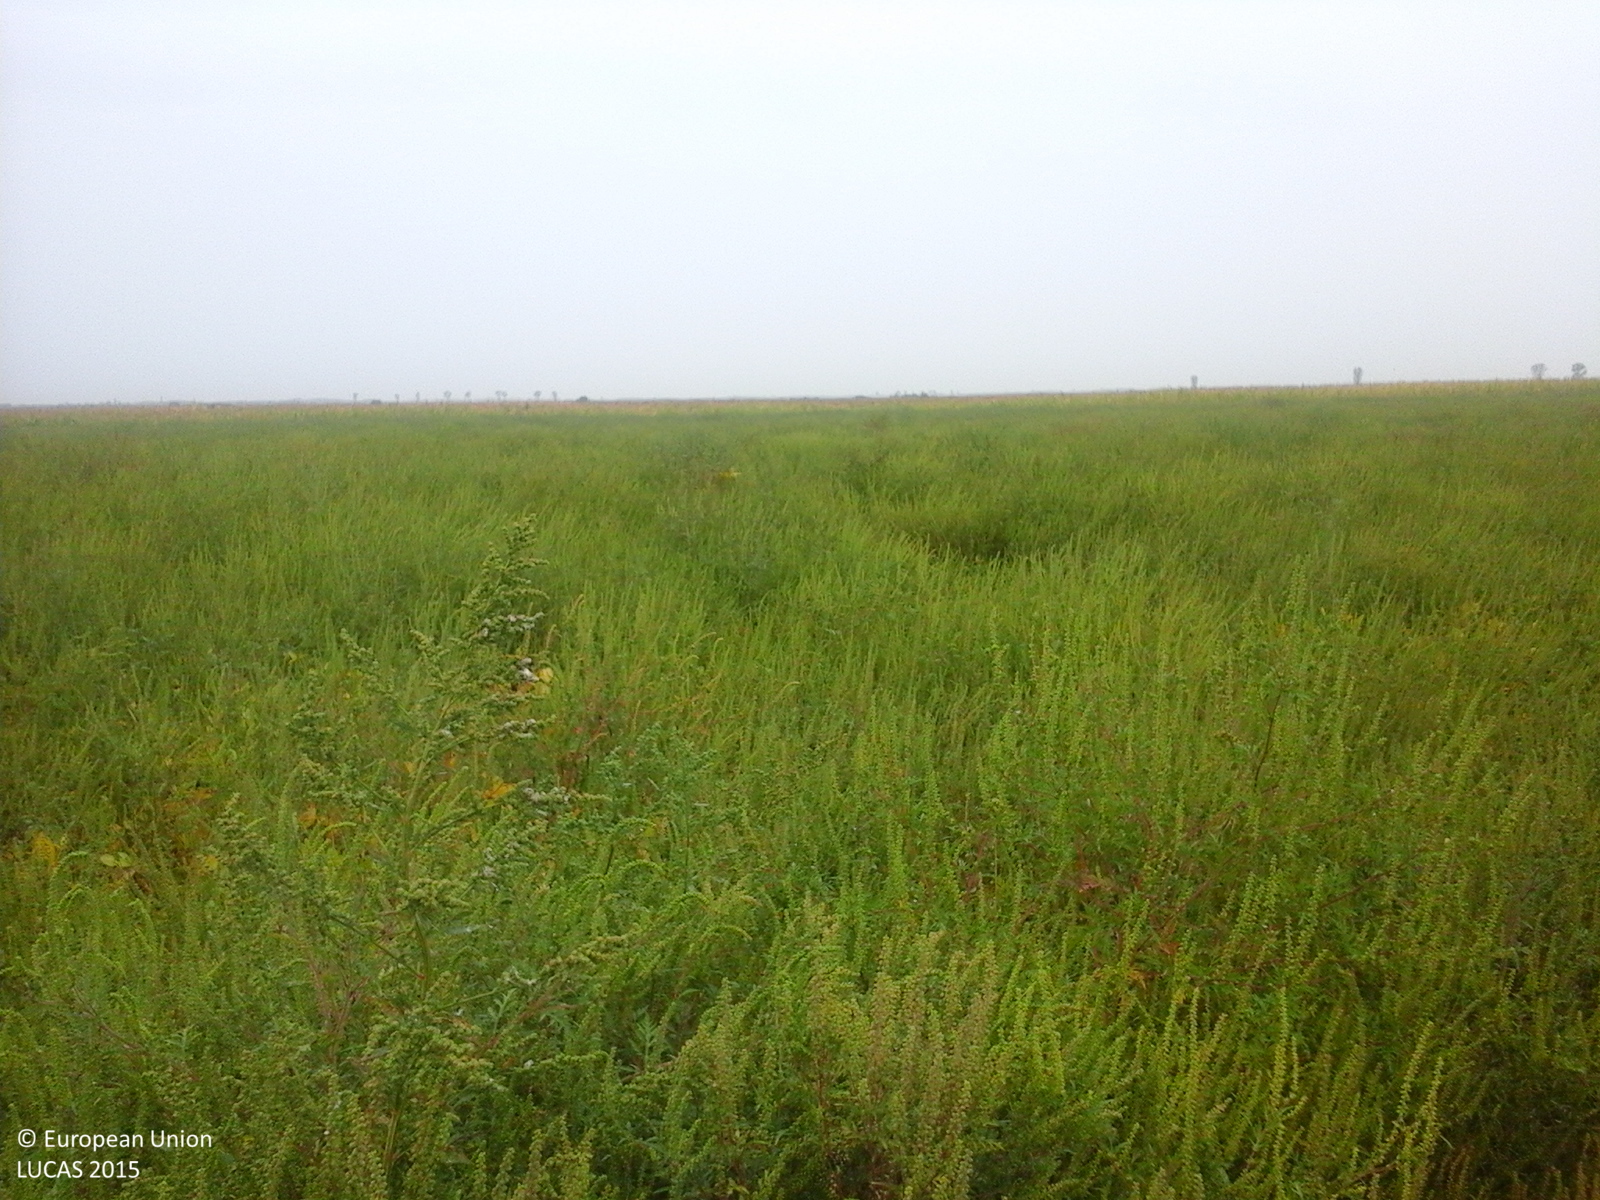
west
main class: Cropland
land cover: Soya
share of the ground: > 75 %
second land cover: Spontaneously vegetated surfaces
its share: > 75 %
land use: Agriculture (excluding fallow land and kitchen gardens)
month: September
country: RO
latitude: 47.7806
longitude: 22.5107
